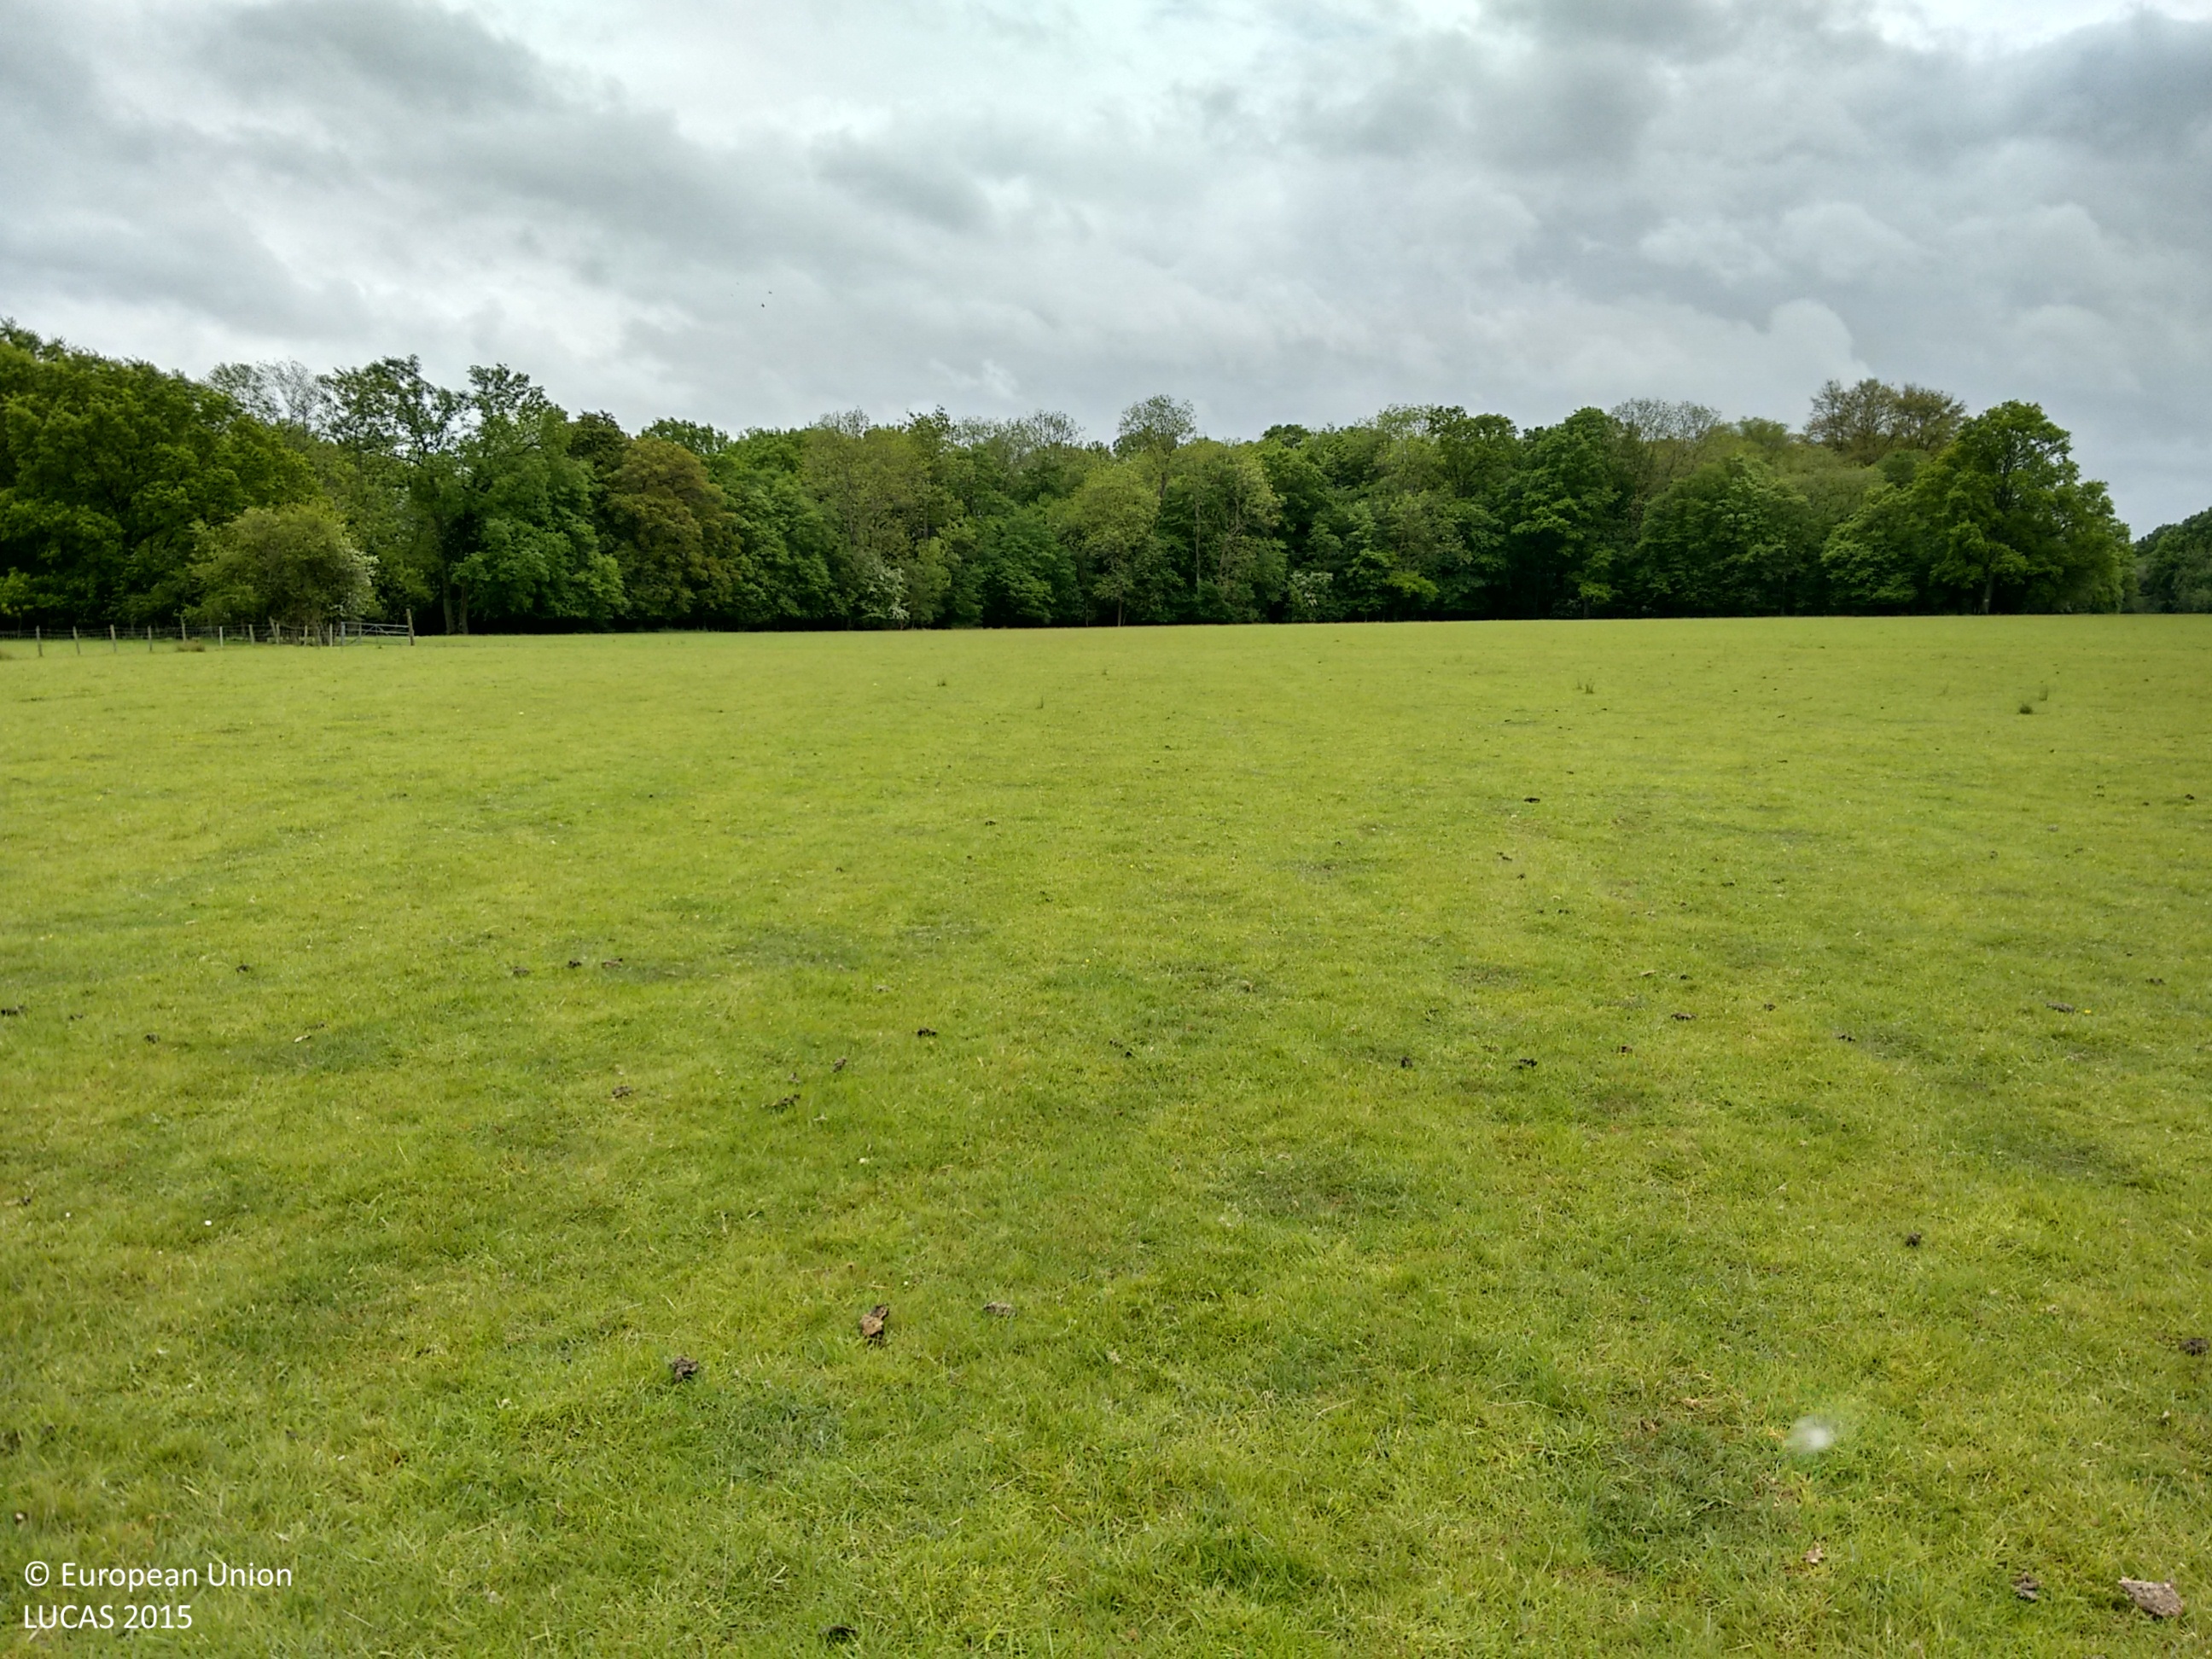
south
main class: Grassland
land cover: Grassland without tree/shrub cover
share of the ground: > 75 %
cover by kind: herbaceous plants 100 %
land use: Agriculture (excluding fallow land and kitchen gardens)
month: May
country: GB
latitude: 51.1938
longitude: 0.6581
